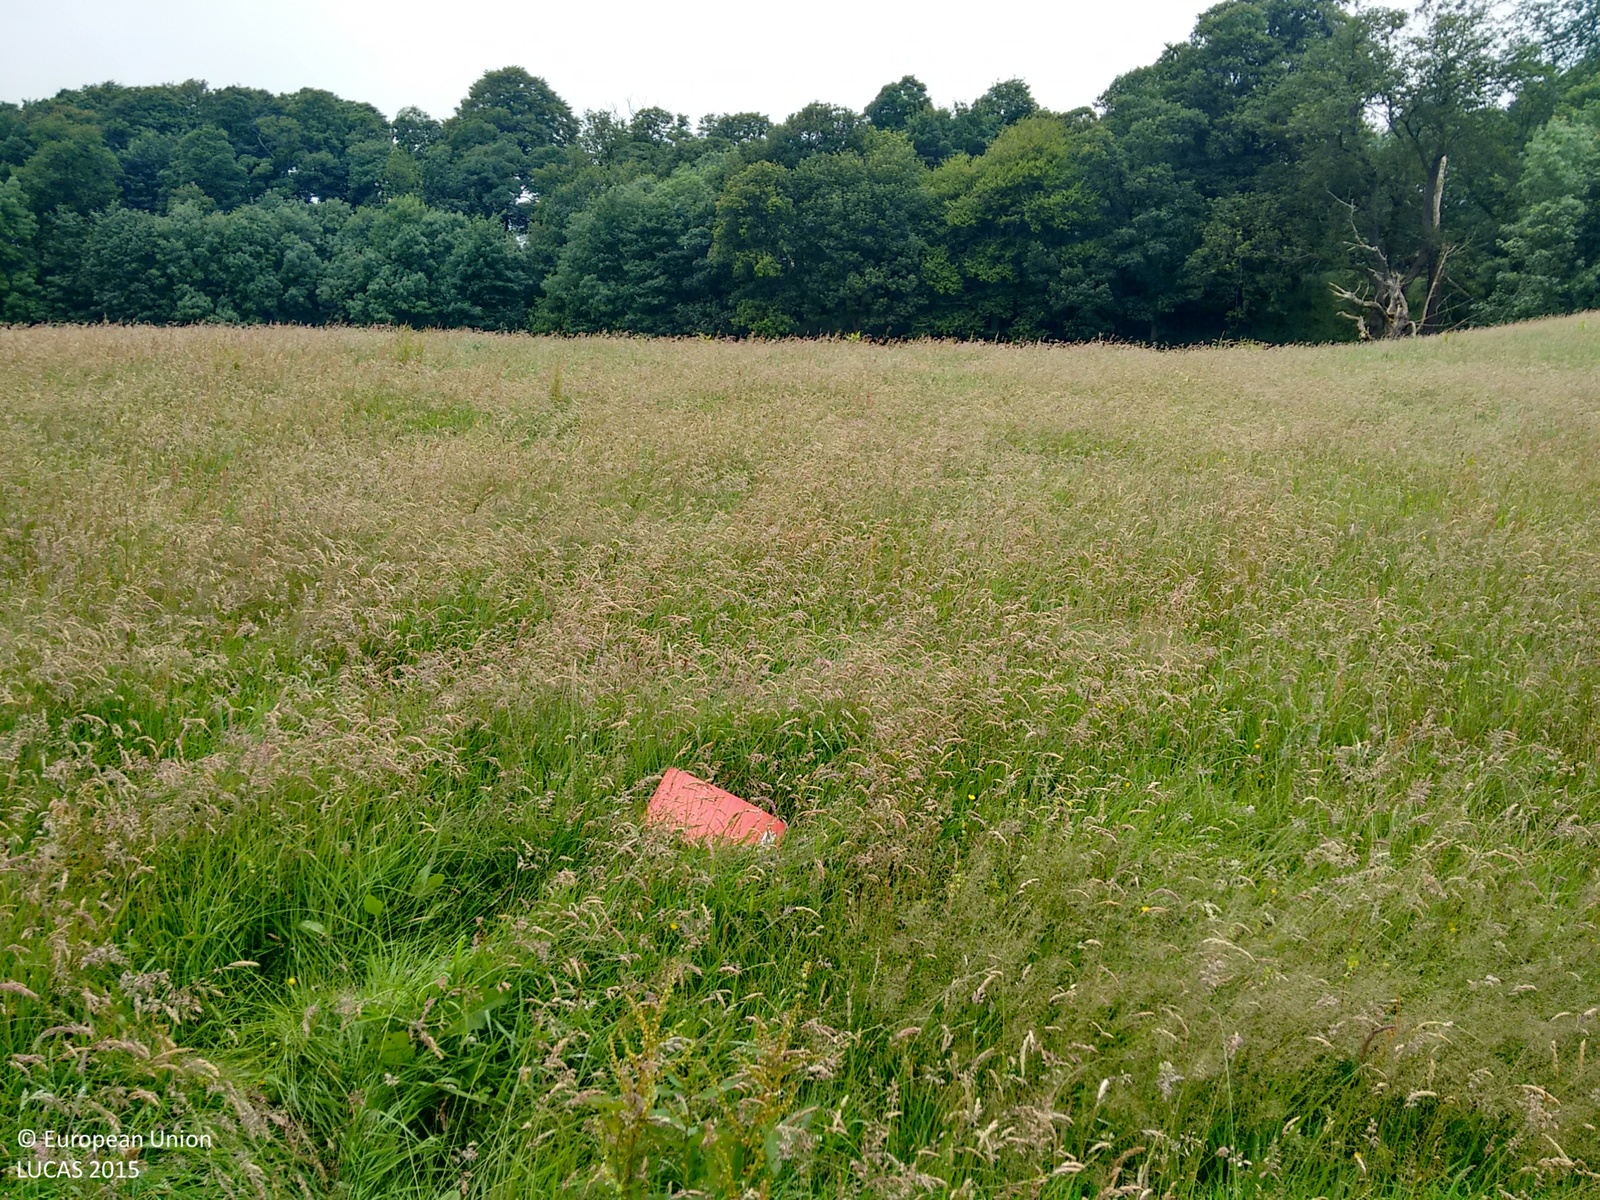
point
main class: Grassland
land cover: Grassland without tree/shrub cover
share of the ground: > 75 %
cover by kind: herbaceous plants 100 %
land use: Agriculture (excluding fallow land and kitchen gardens)
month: July
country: GB
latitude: 54.9399
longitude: -3.9991
